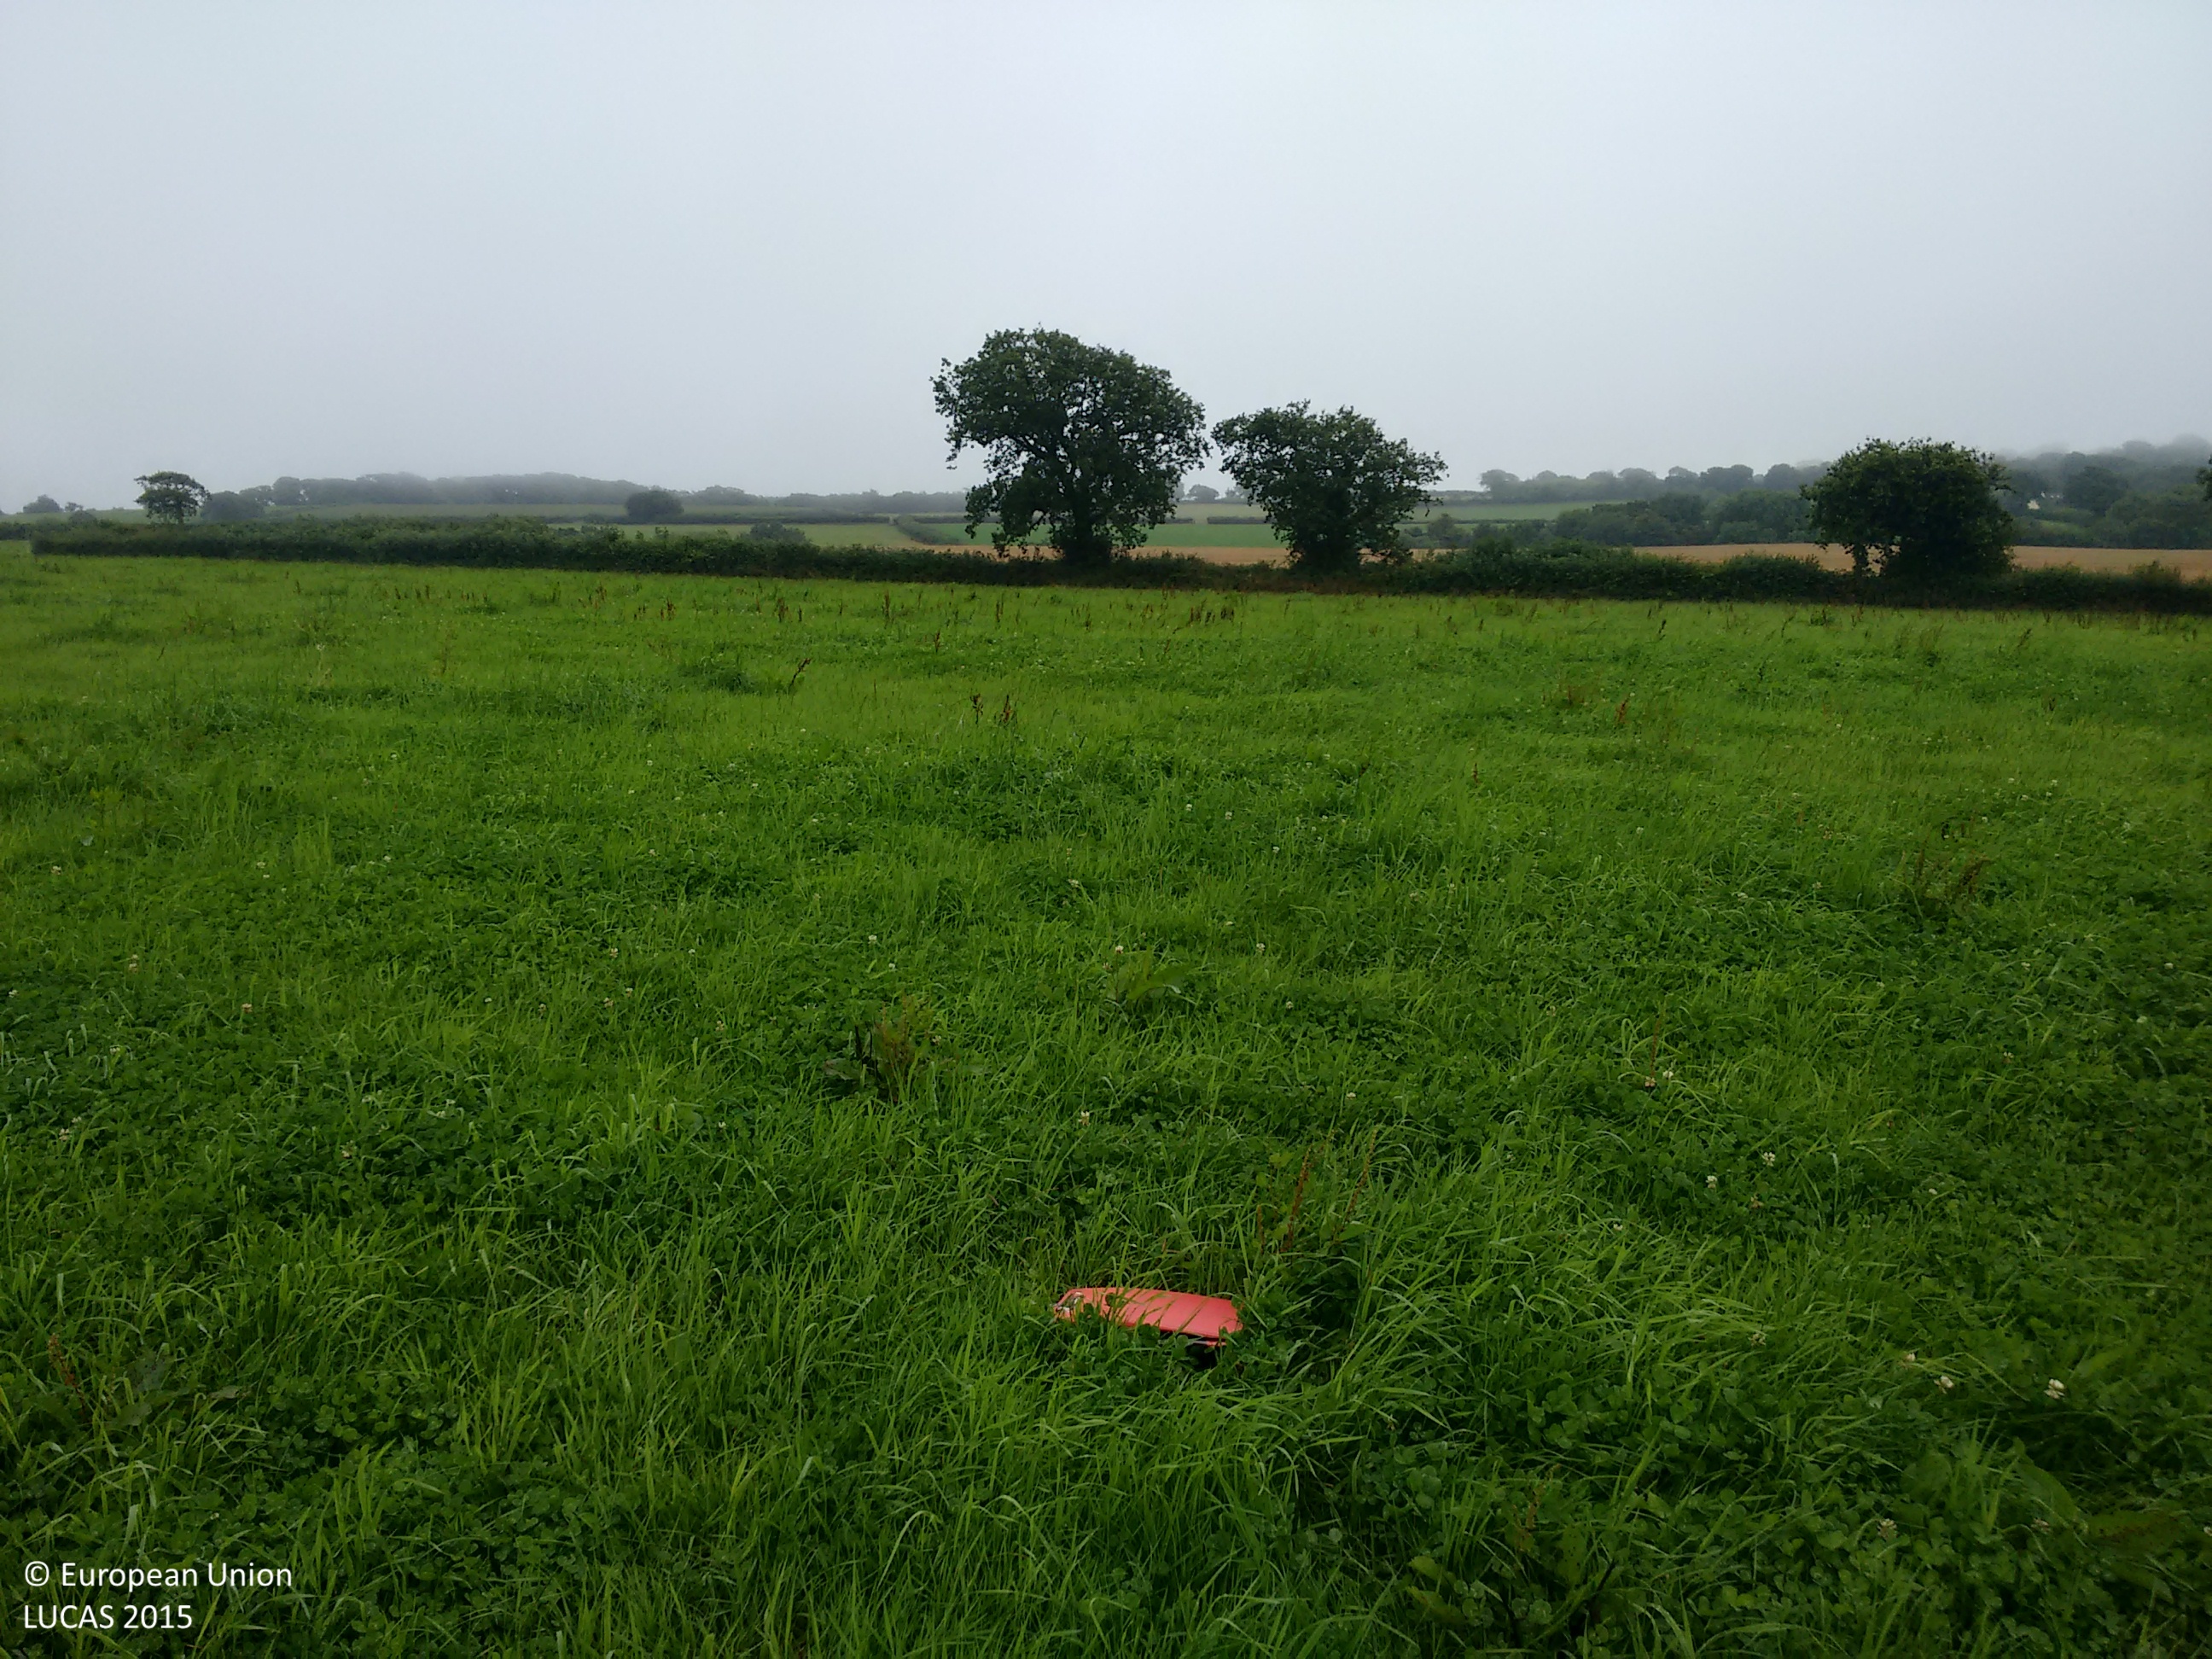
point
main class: Grassland
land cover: Grassland without tree/shrub cover
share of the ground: > 75 %
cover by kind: herbaceous plants 100 %
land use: Agriculture (excluding fallow land and kitchen gardens)
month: August
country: GB
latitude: 50.8858
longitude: -3.6914
